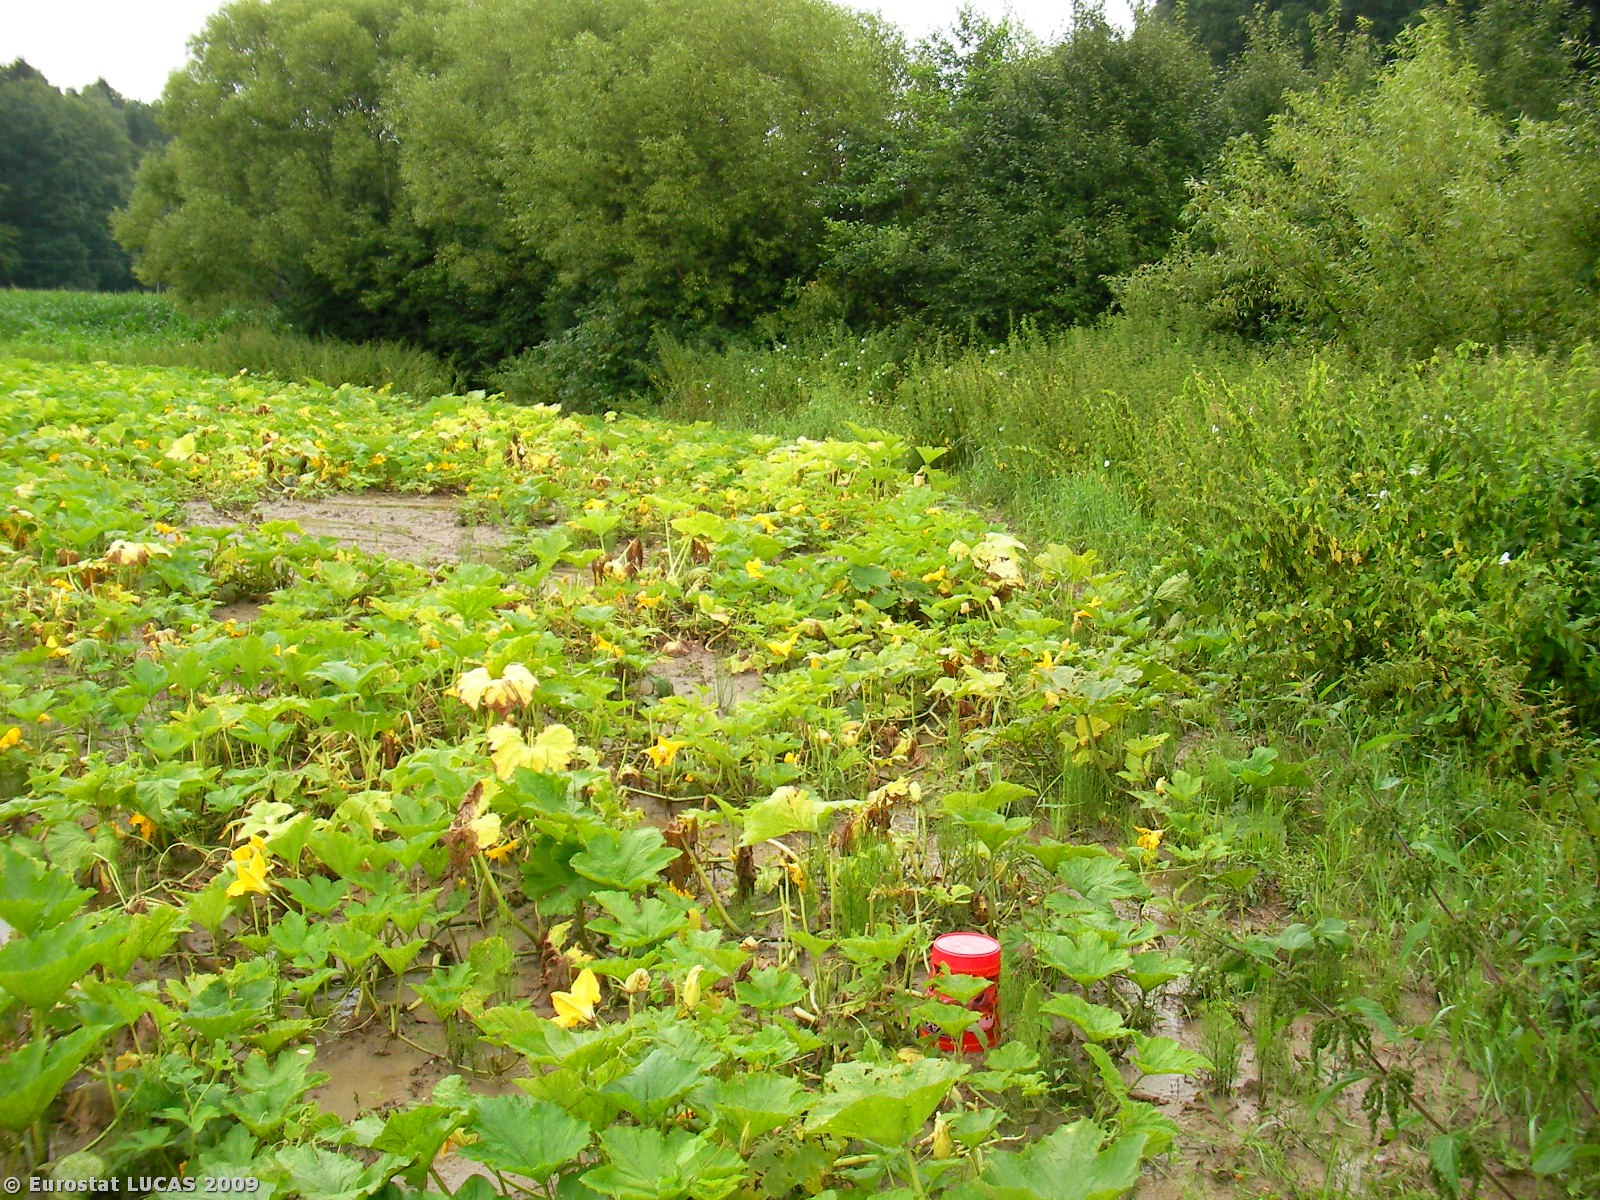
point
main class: Cropland
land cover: Other fibre and oleaginous crops
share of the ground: > 75 %
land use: Agriculture (excluding fallow land and kitchen gardens)
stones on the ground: < 10 %
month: July
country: AT
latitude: 46.9386
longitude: 15.7144
